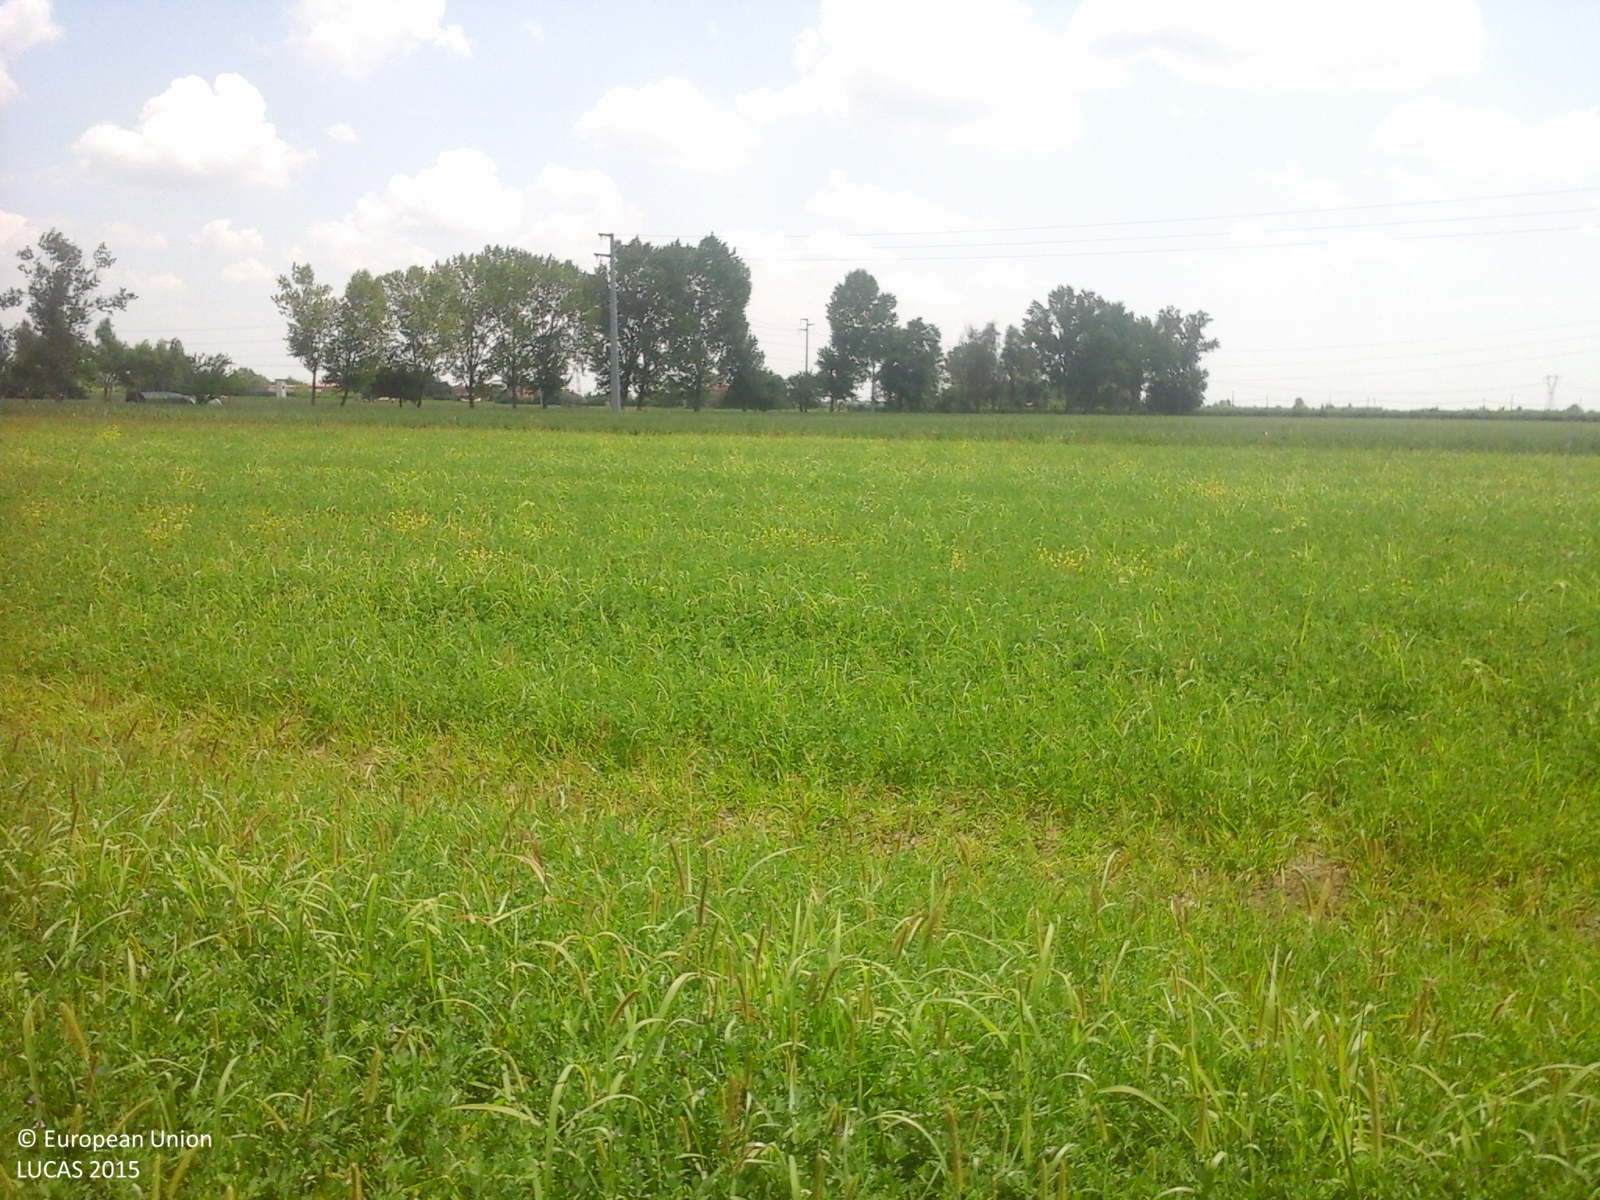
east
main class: Cropland
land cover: Lucerne
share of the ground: > 75 %
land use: Agriculture (excluding fallow land and kitchen gardens)
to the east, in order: Lucerne; Ditches and canals; Lucerne; Ditches and canals; Lucerne; Grass margins; Ditches and canals; Grass margins; Lucerne; Electric lines; Lucerne; Ditches and canals; Lucerne; Ditches and canals; Lucerne; Electric lines; Lucerne; Grass margins; Ditches and canals; Lines of trees; Grass margins; Lucerne; Ditches and canals; Other bare soil; Ditches and canals; Other bare soil
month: June
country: IT
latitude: 44.8154
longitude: 10.9212
